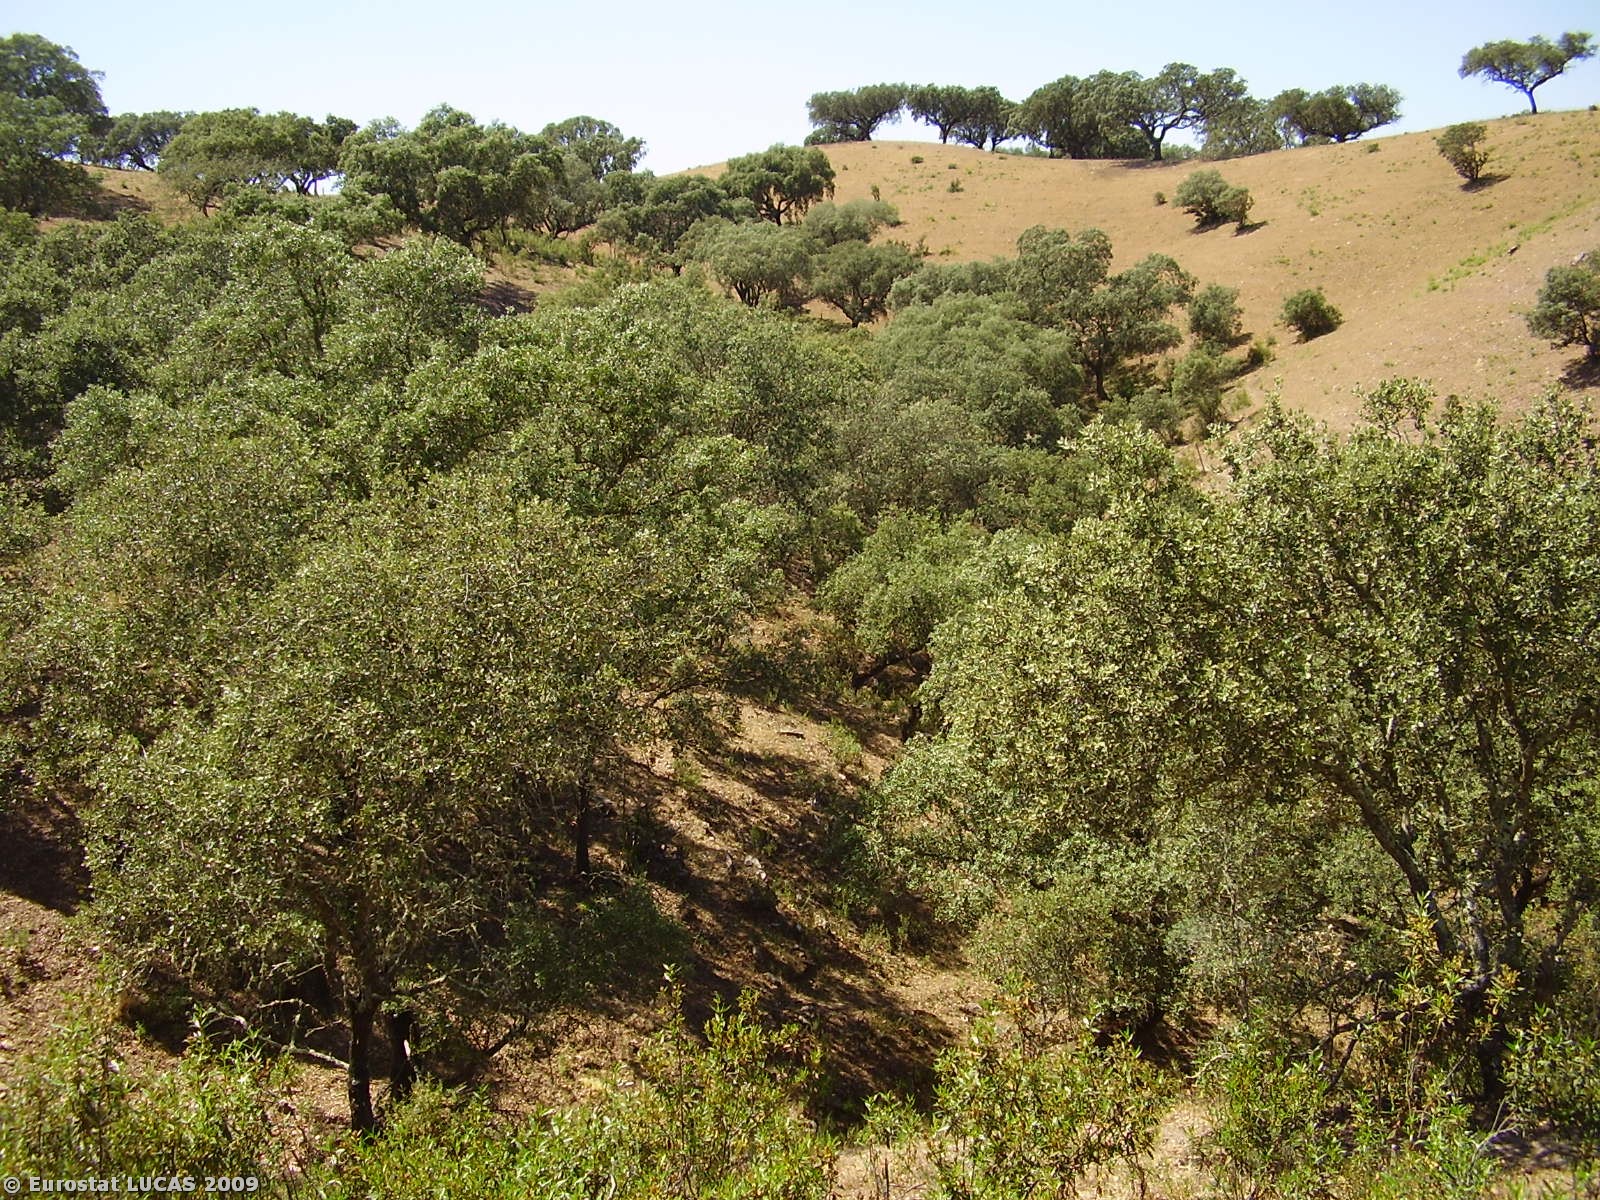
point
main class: Woodland
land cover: Broadleaved woodland
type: broadleaved evergreen forest
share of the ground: 50 - 75 %
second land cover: Bare land
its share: 25 - 50 %
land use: Forestry
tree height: > 5 m
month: May
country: PT
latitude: 37.8686
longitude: -7.7908
